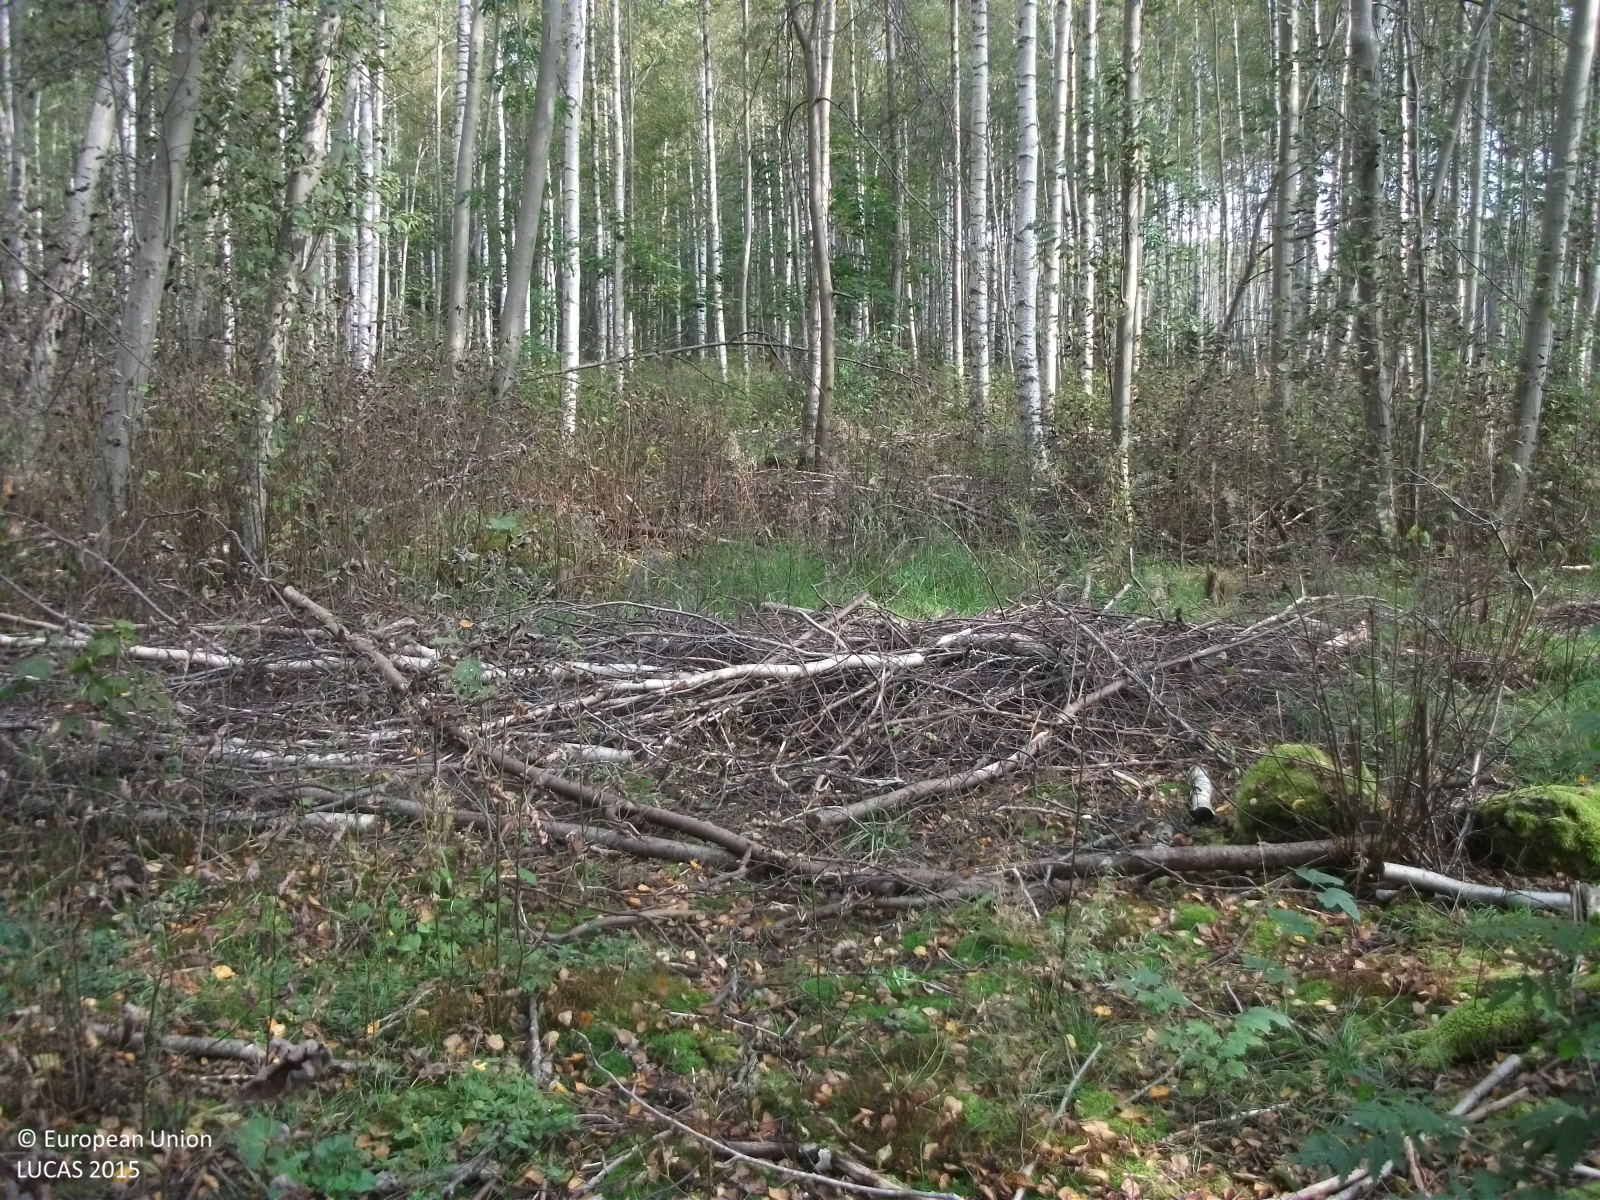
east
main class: Woodland
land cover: Broadleaved woodland
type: non-riverine alder, birch or aspen forest
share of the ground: > 75 %
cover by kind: broadleaved forest trees 80 %, herbaceous plants 10 %, shrubs 5 %
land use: Forestry
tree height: > 5 m
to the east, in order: Broadleaved woodland; Shrubland with sparse tree cover; Ditches and canals; Shrubland with sparse tree cover; Spontaneously vegetated surfaces
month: September
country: LV
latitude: 57.7965
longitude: 24.4732
